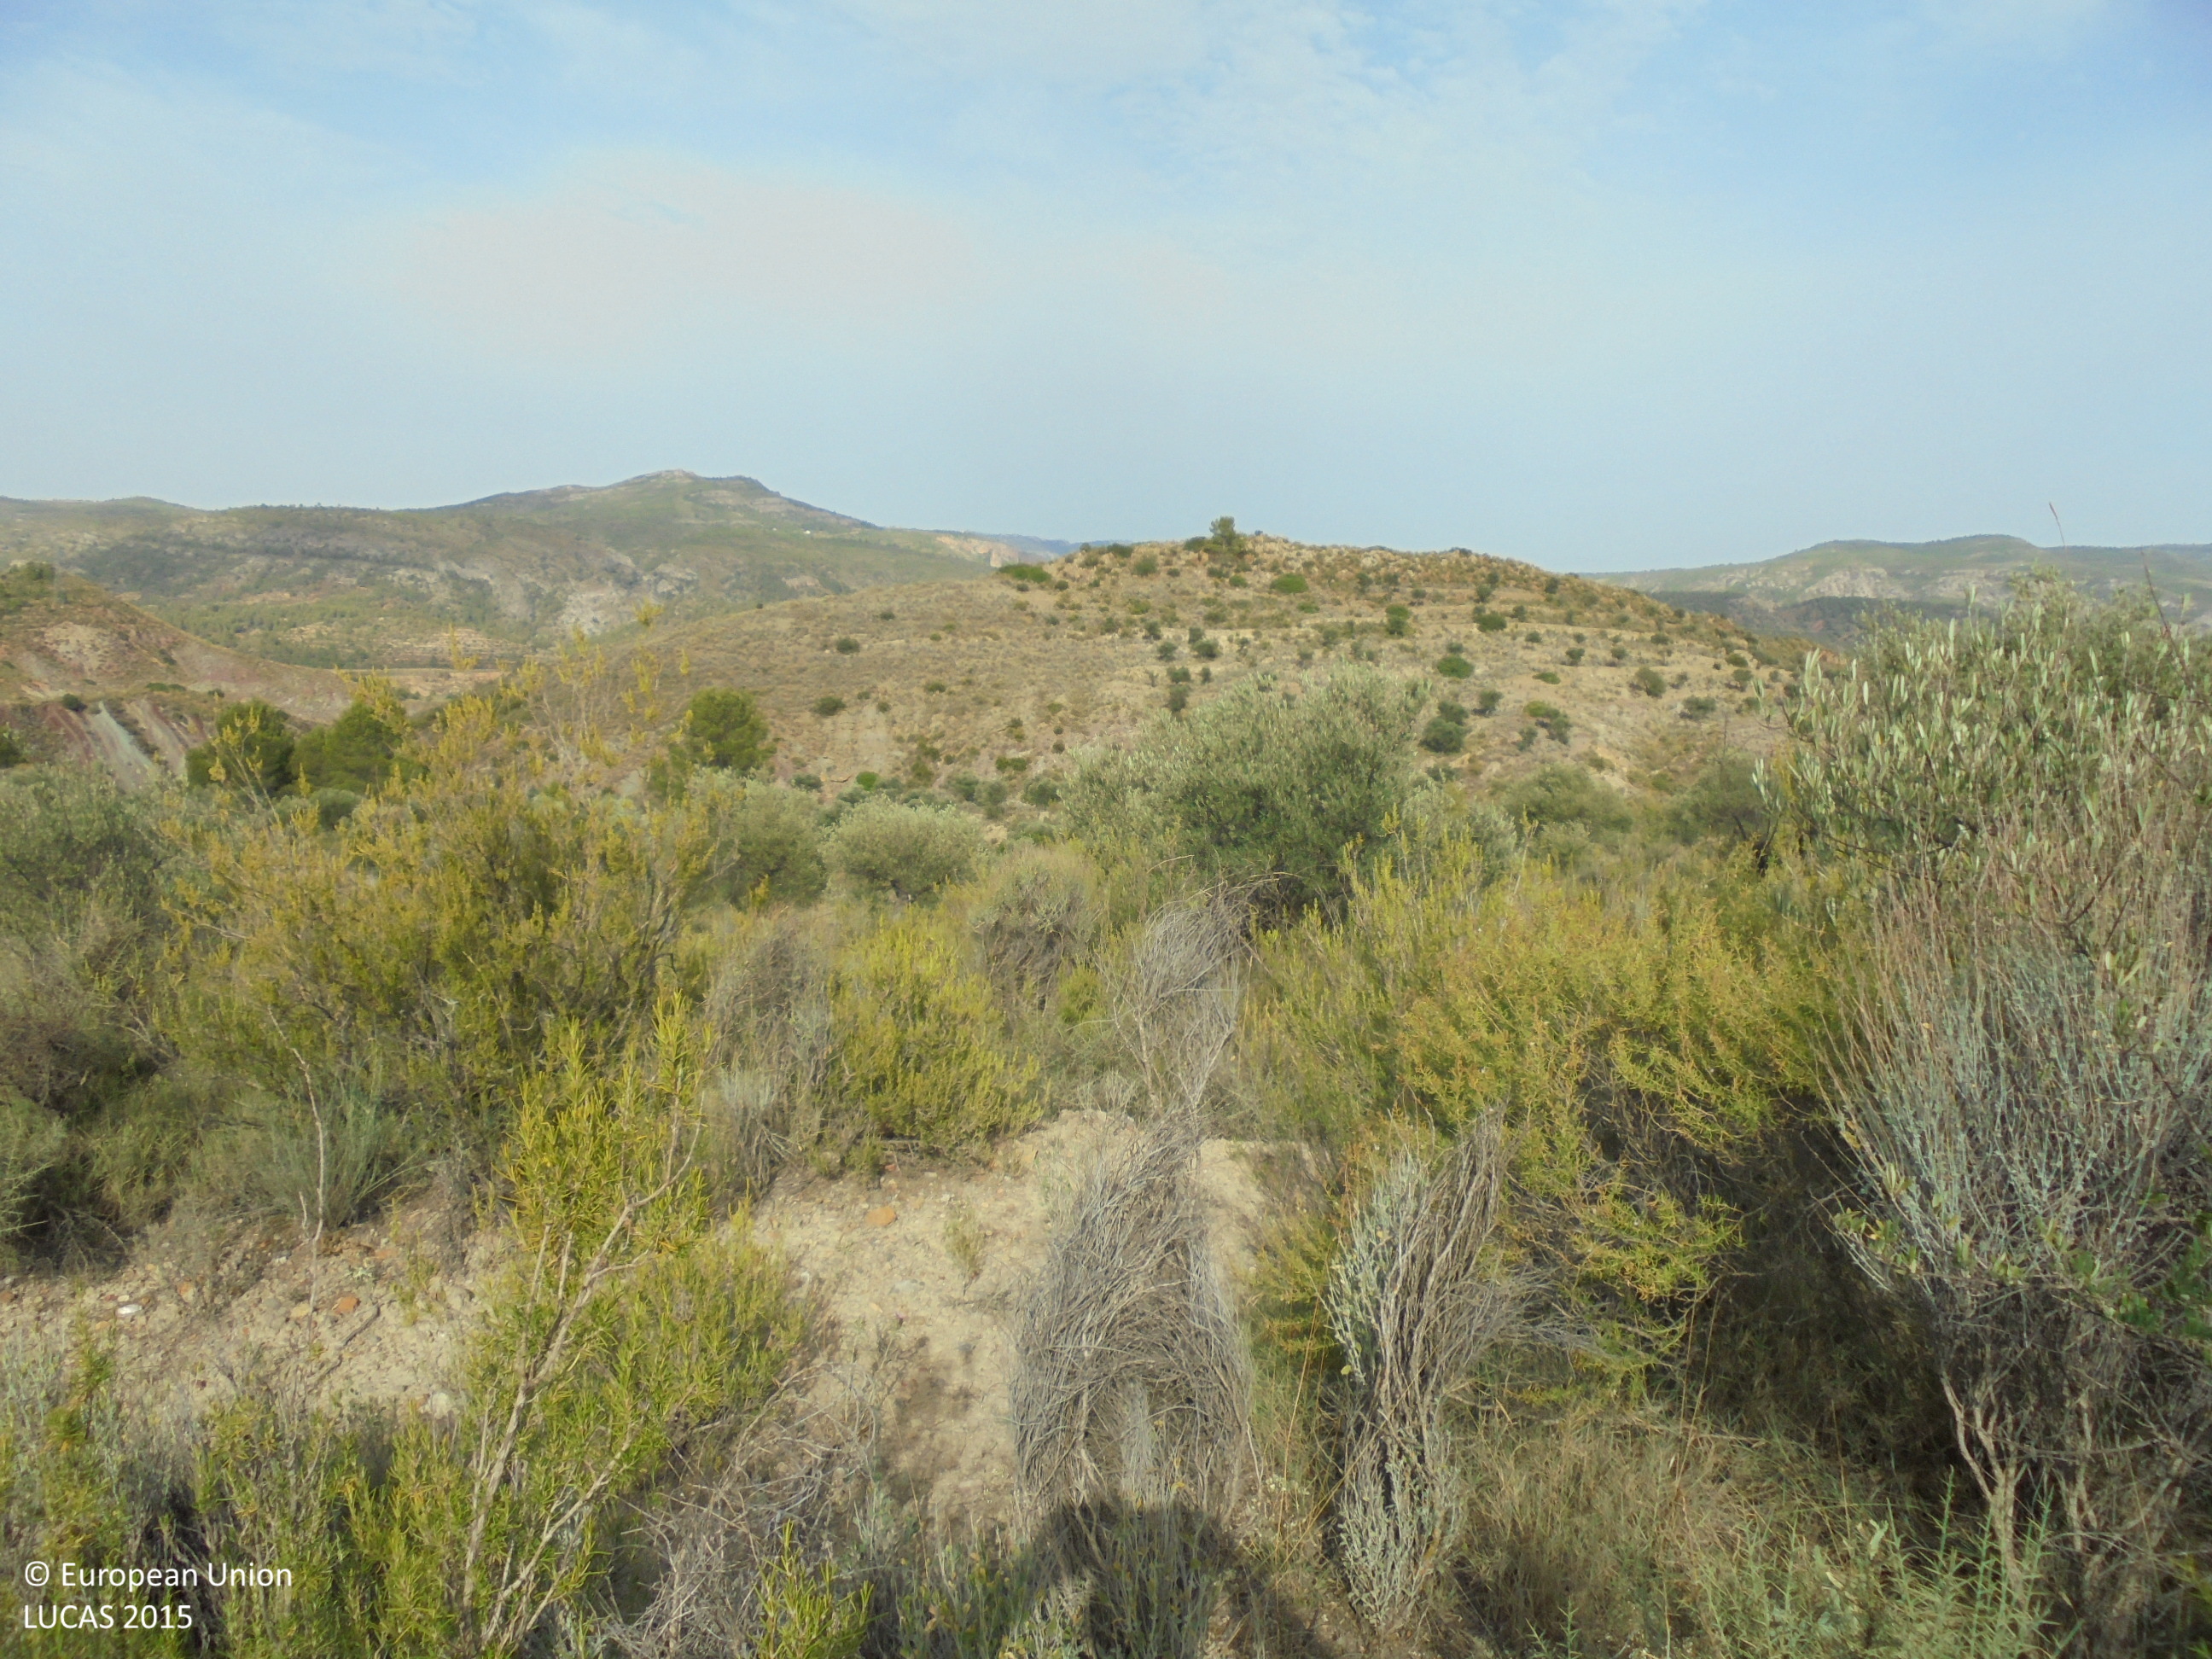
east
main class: Shrubland
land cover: Shrubland with sparse tree cover
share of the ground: > 75 %
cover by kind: shrubs 80 %, unconsolidated bare surface 15 %, coniferous forest trees 5 %
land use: Abandoned areas
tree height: > 5 m
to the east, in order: Shrubland with sparse tree cover; Olive groves; Dry stone walls; Shrubland without tree cover; Olive groves; Dry stone walls; Olive groves; Shruby margins; Olive groves; Shrubland with sparse tree cover
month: August
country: ES
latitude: 39.1639
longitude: -1.0732
